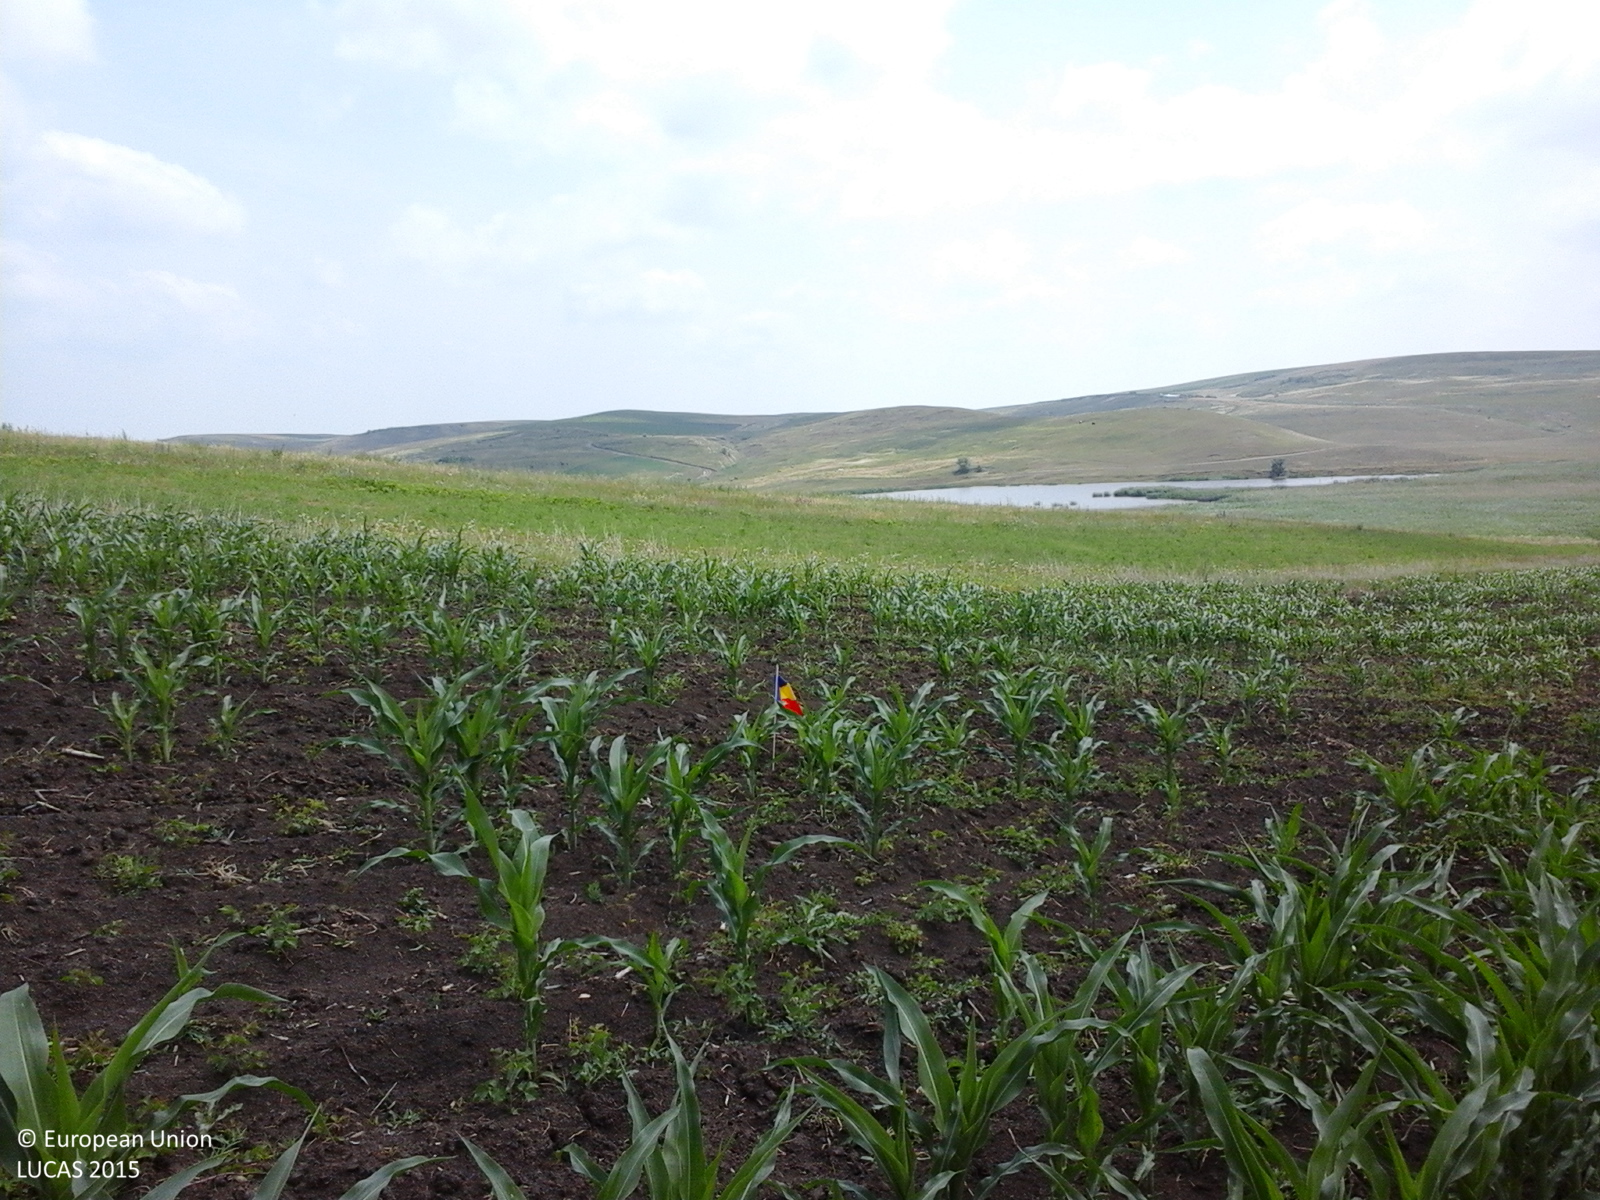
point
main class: Cropland
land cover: Maize
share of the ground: 25 - 50 %
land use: Agriculture (excluding fallow land and kitchen gardens)
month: June
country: RO
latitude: 48.0496
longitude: 26.6374
